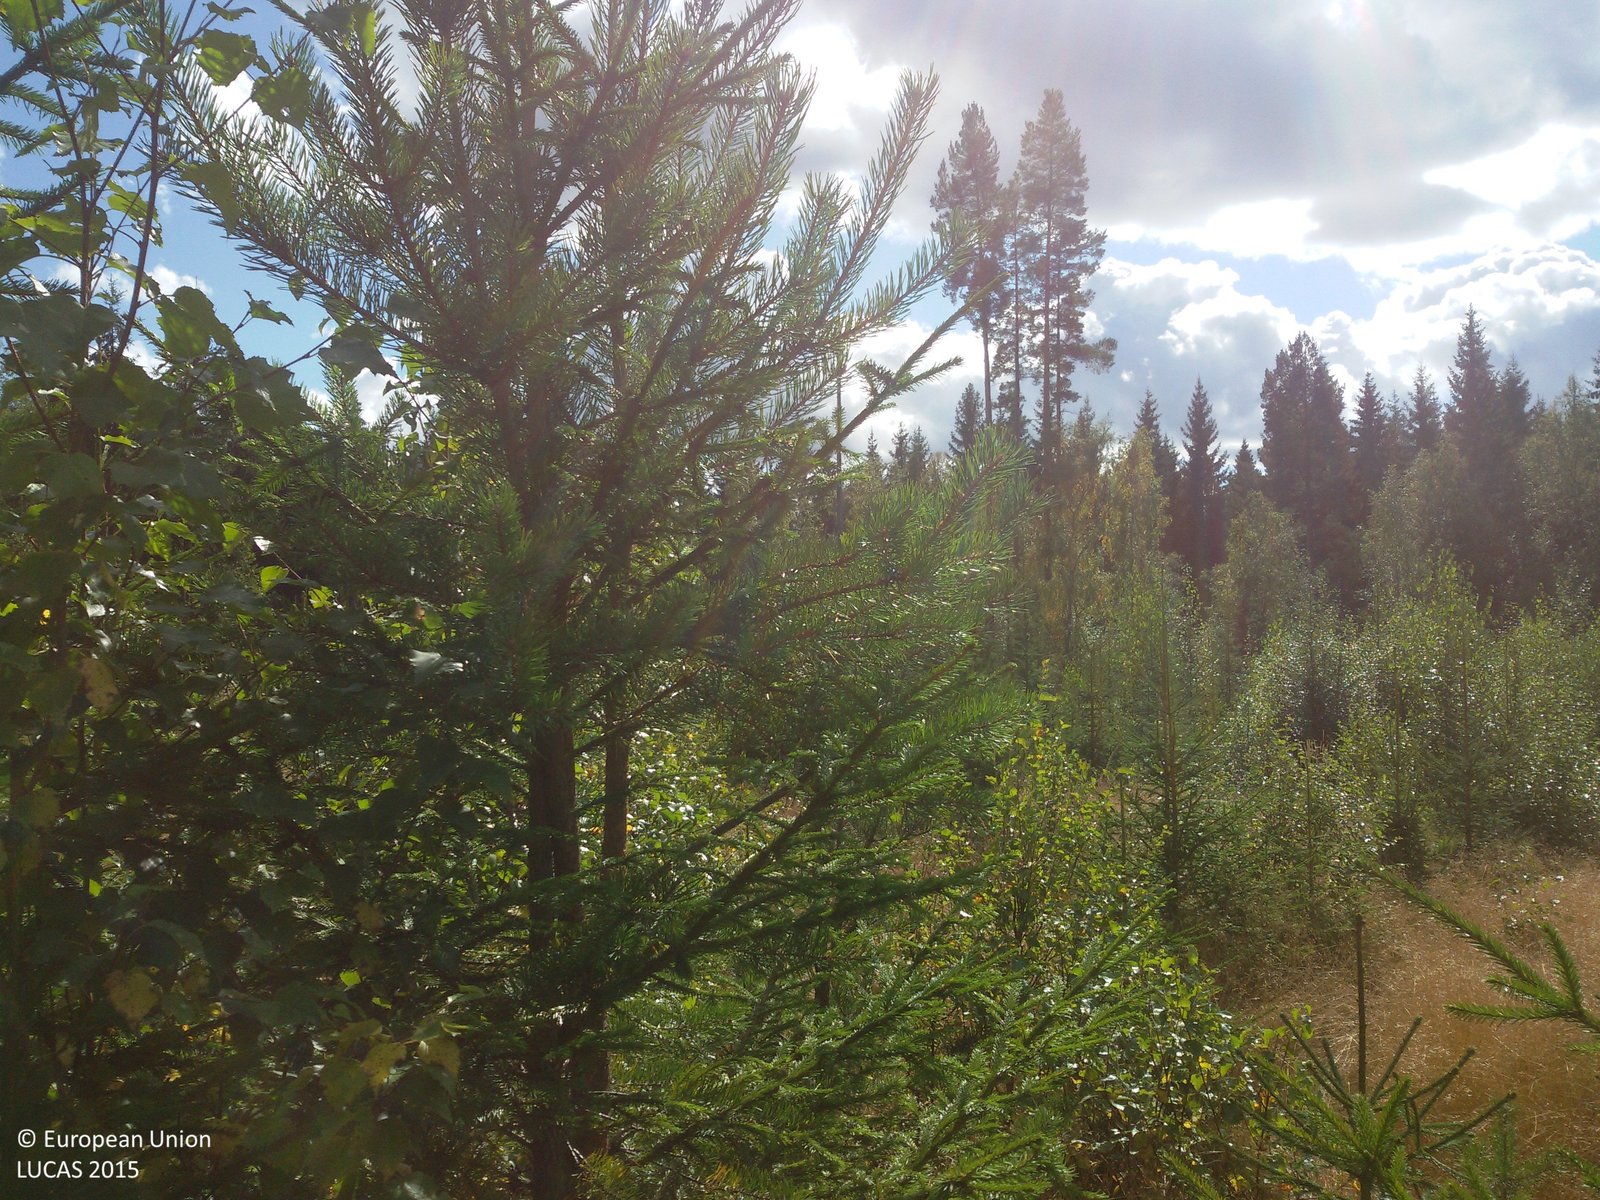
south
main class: Woodland
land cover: Spruce dominated mixed woodland
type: boreal forest
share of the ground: 50 - 75 %
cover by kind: herbaceous plants 45 %, coniferous forest trees 35 %, broadleaved forest trees 20 %
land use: Forestry
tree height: < 5 m
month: August
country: SE
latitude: 60.6637
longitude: 15.6412
